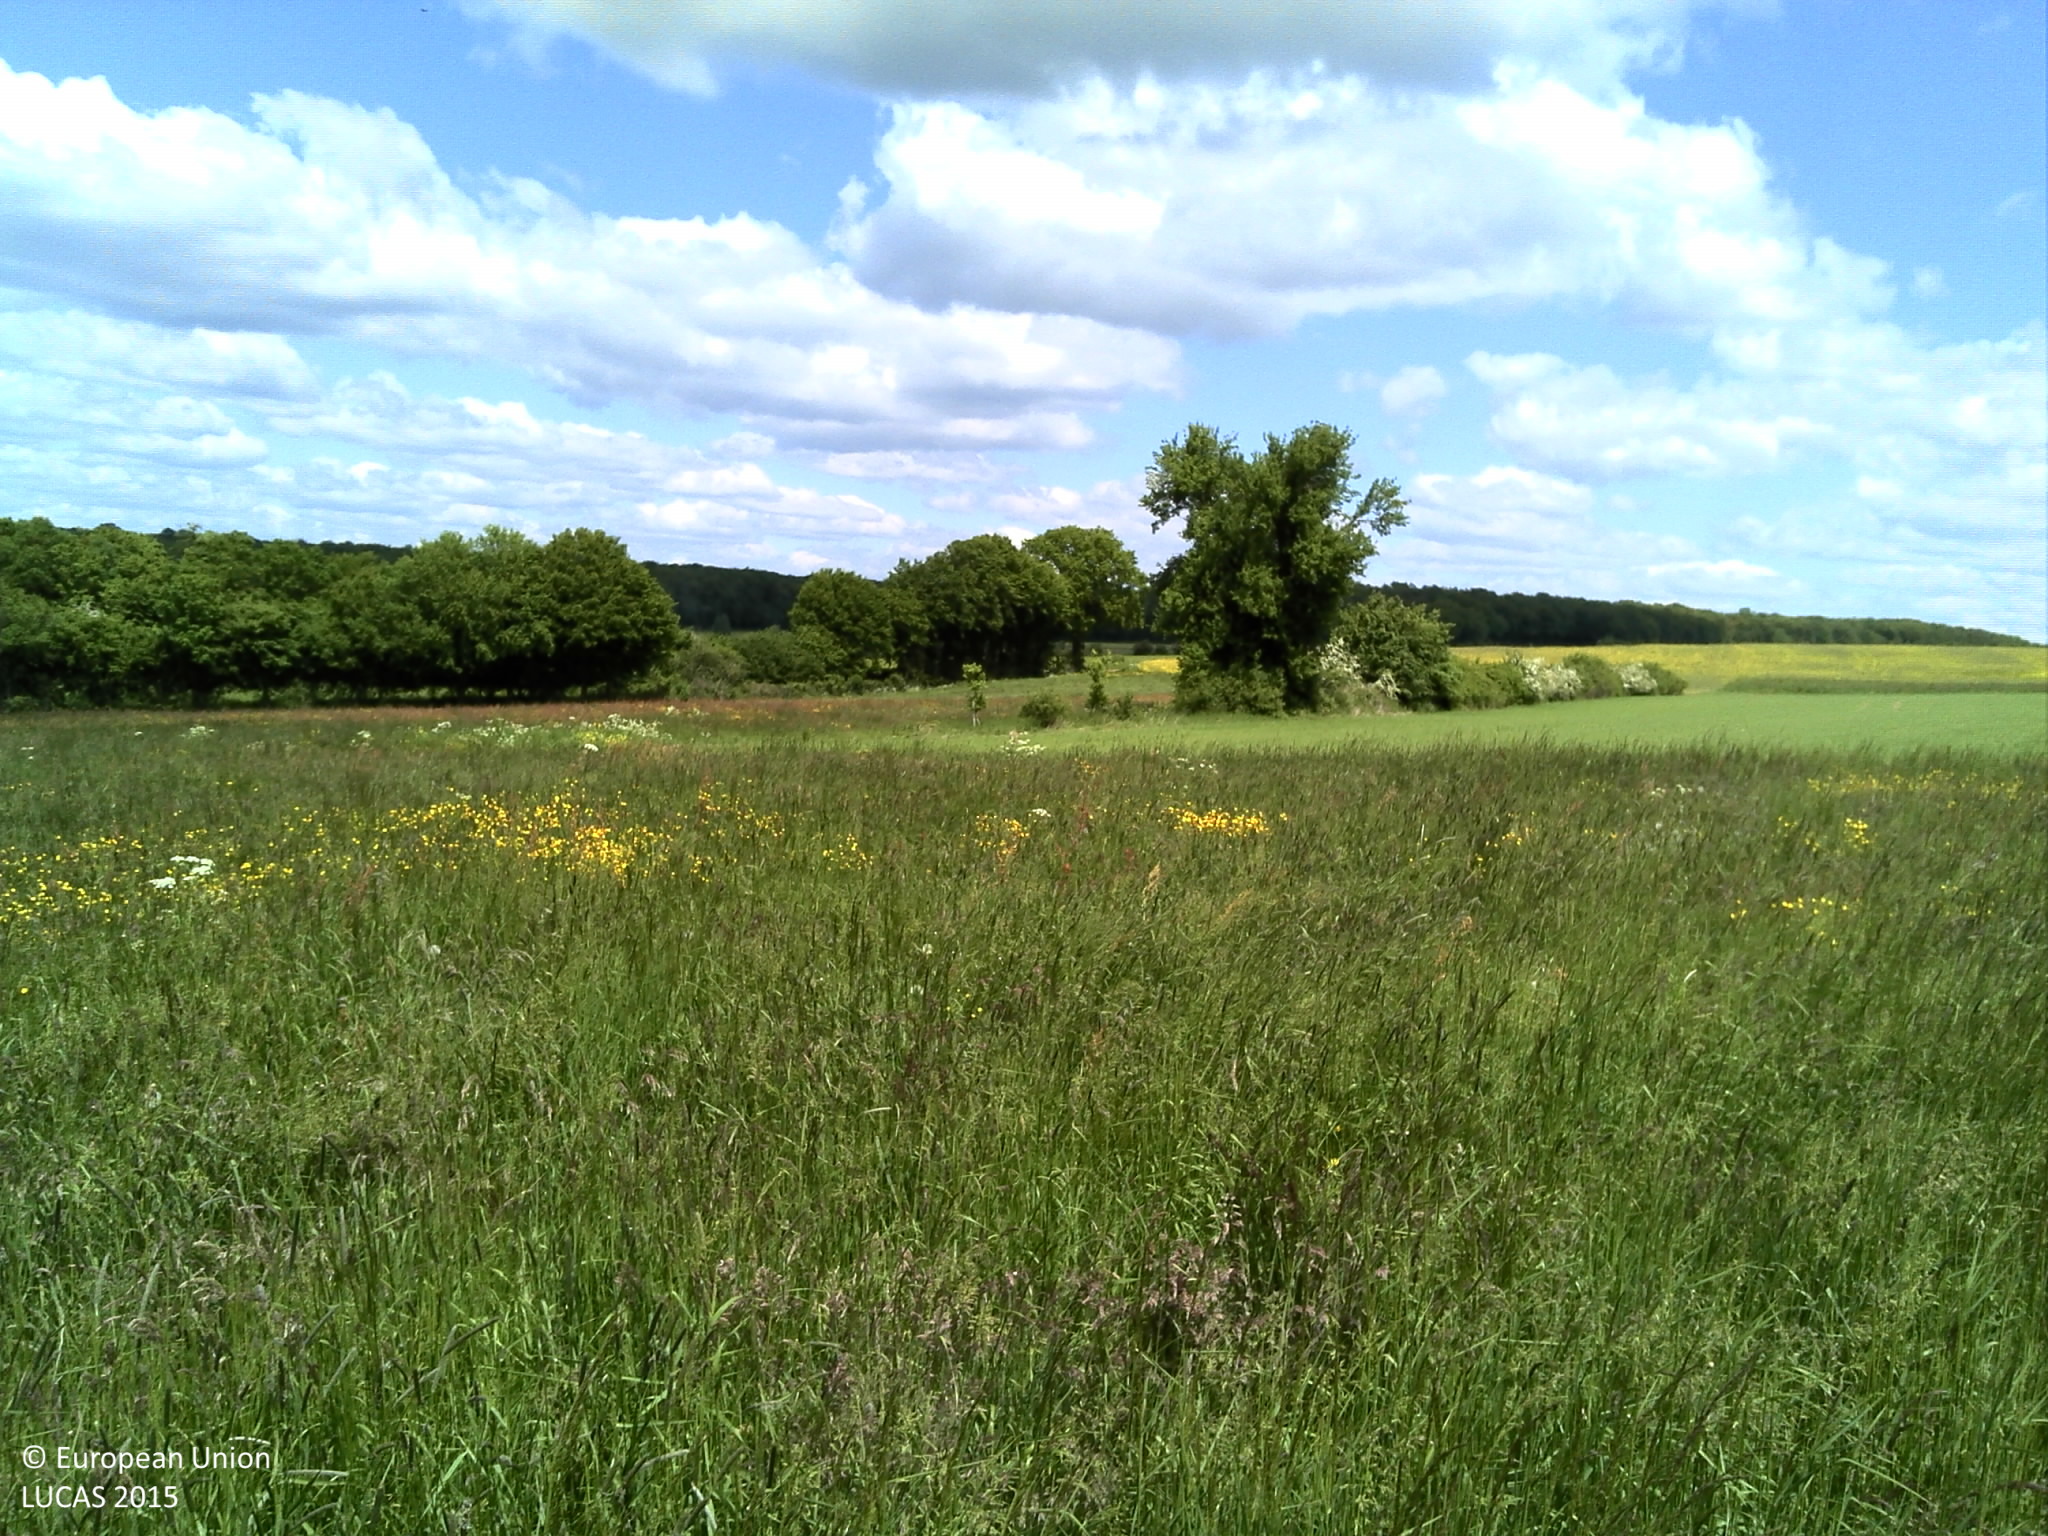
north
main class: Cropland
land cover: Temporary grasslands
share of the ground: > 75 %
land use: Agriculture (excluding fallow land and kitchen gardens)
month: May
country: LU
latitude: 49.7186
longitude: 6.0185
